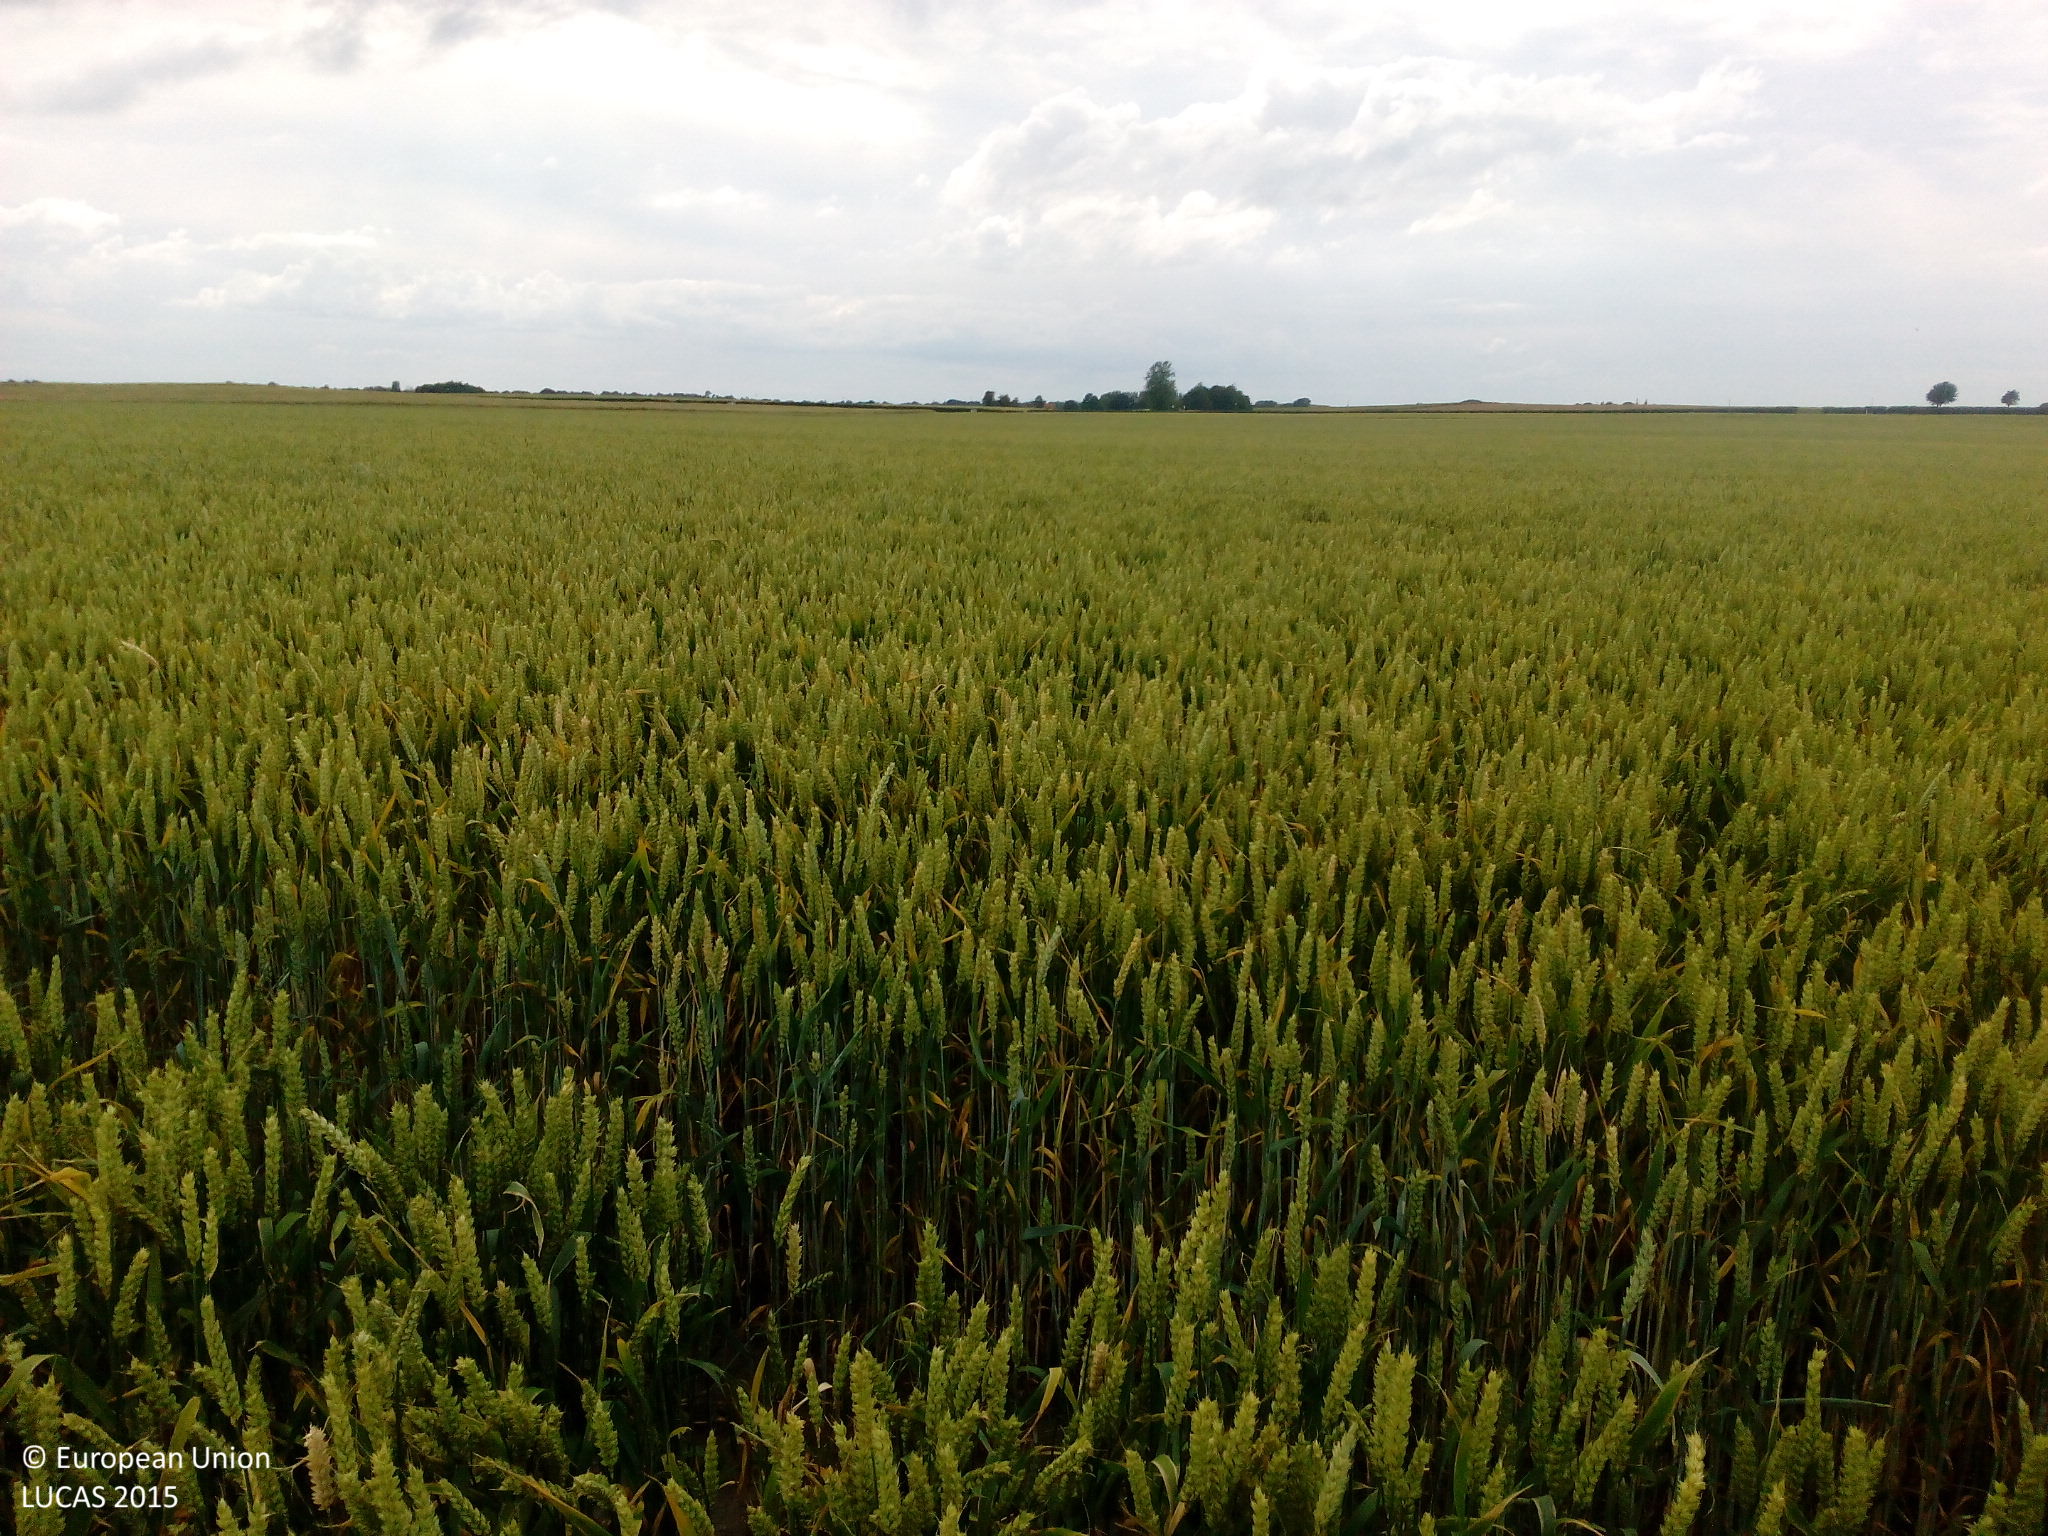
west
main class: Cropland
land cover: Common wheat
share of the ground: > 75 %
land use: Agriculture (excluding fallow land and kitchen gardens)
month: July
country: DK
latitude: 55.4267
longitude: 11.2472
